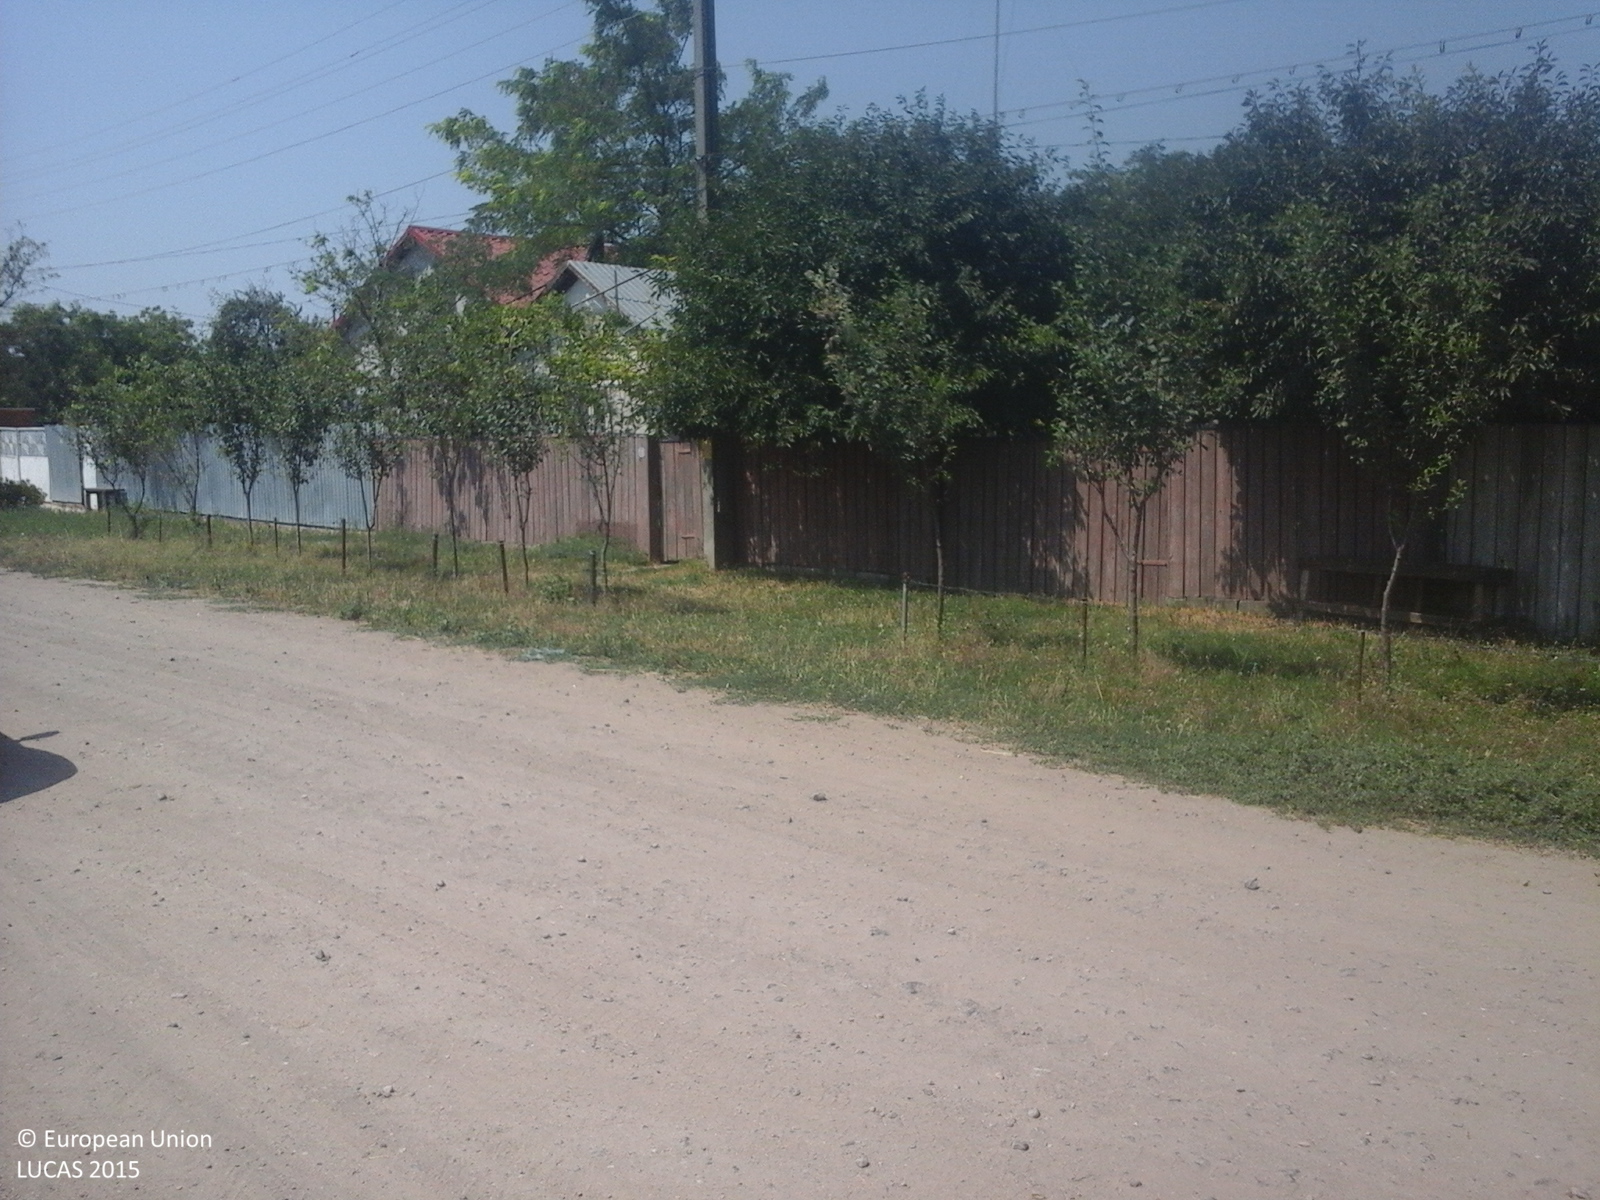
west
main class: Grassland
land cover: Spontaneously vegetated surfaces
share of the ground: > 75 %
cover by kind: herbaceous plants 100 %
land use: Sport
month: August
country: RO
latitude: 45.2295
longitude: 27.8003
